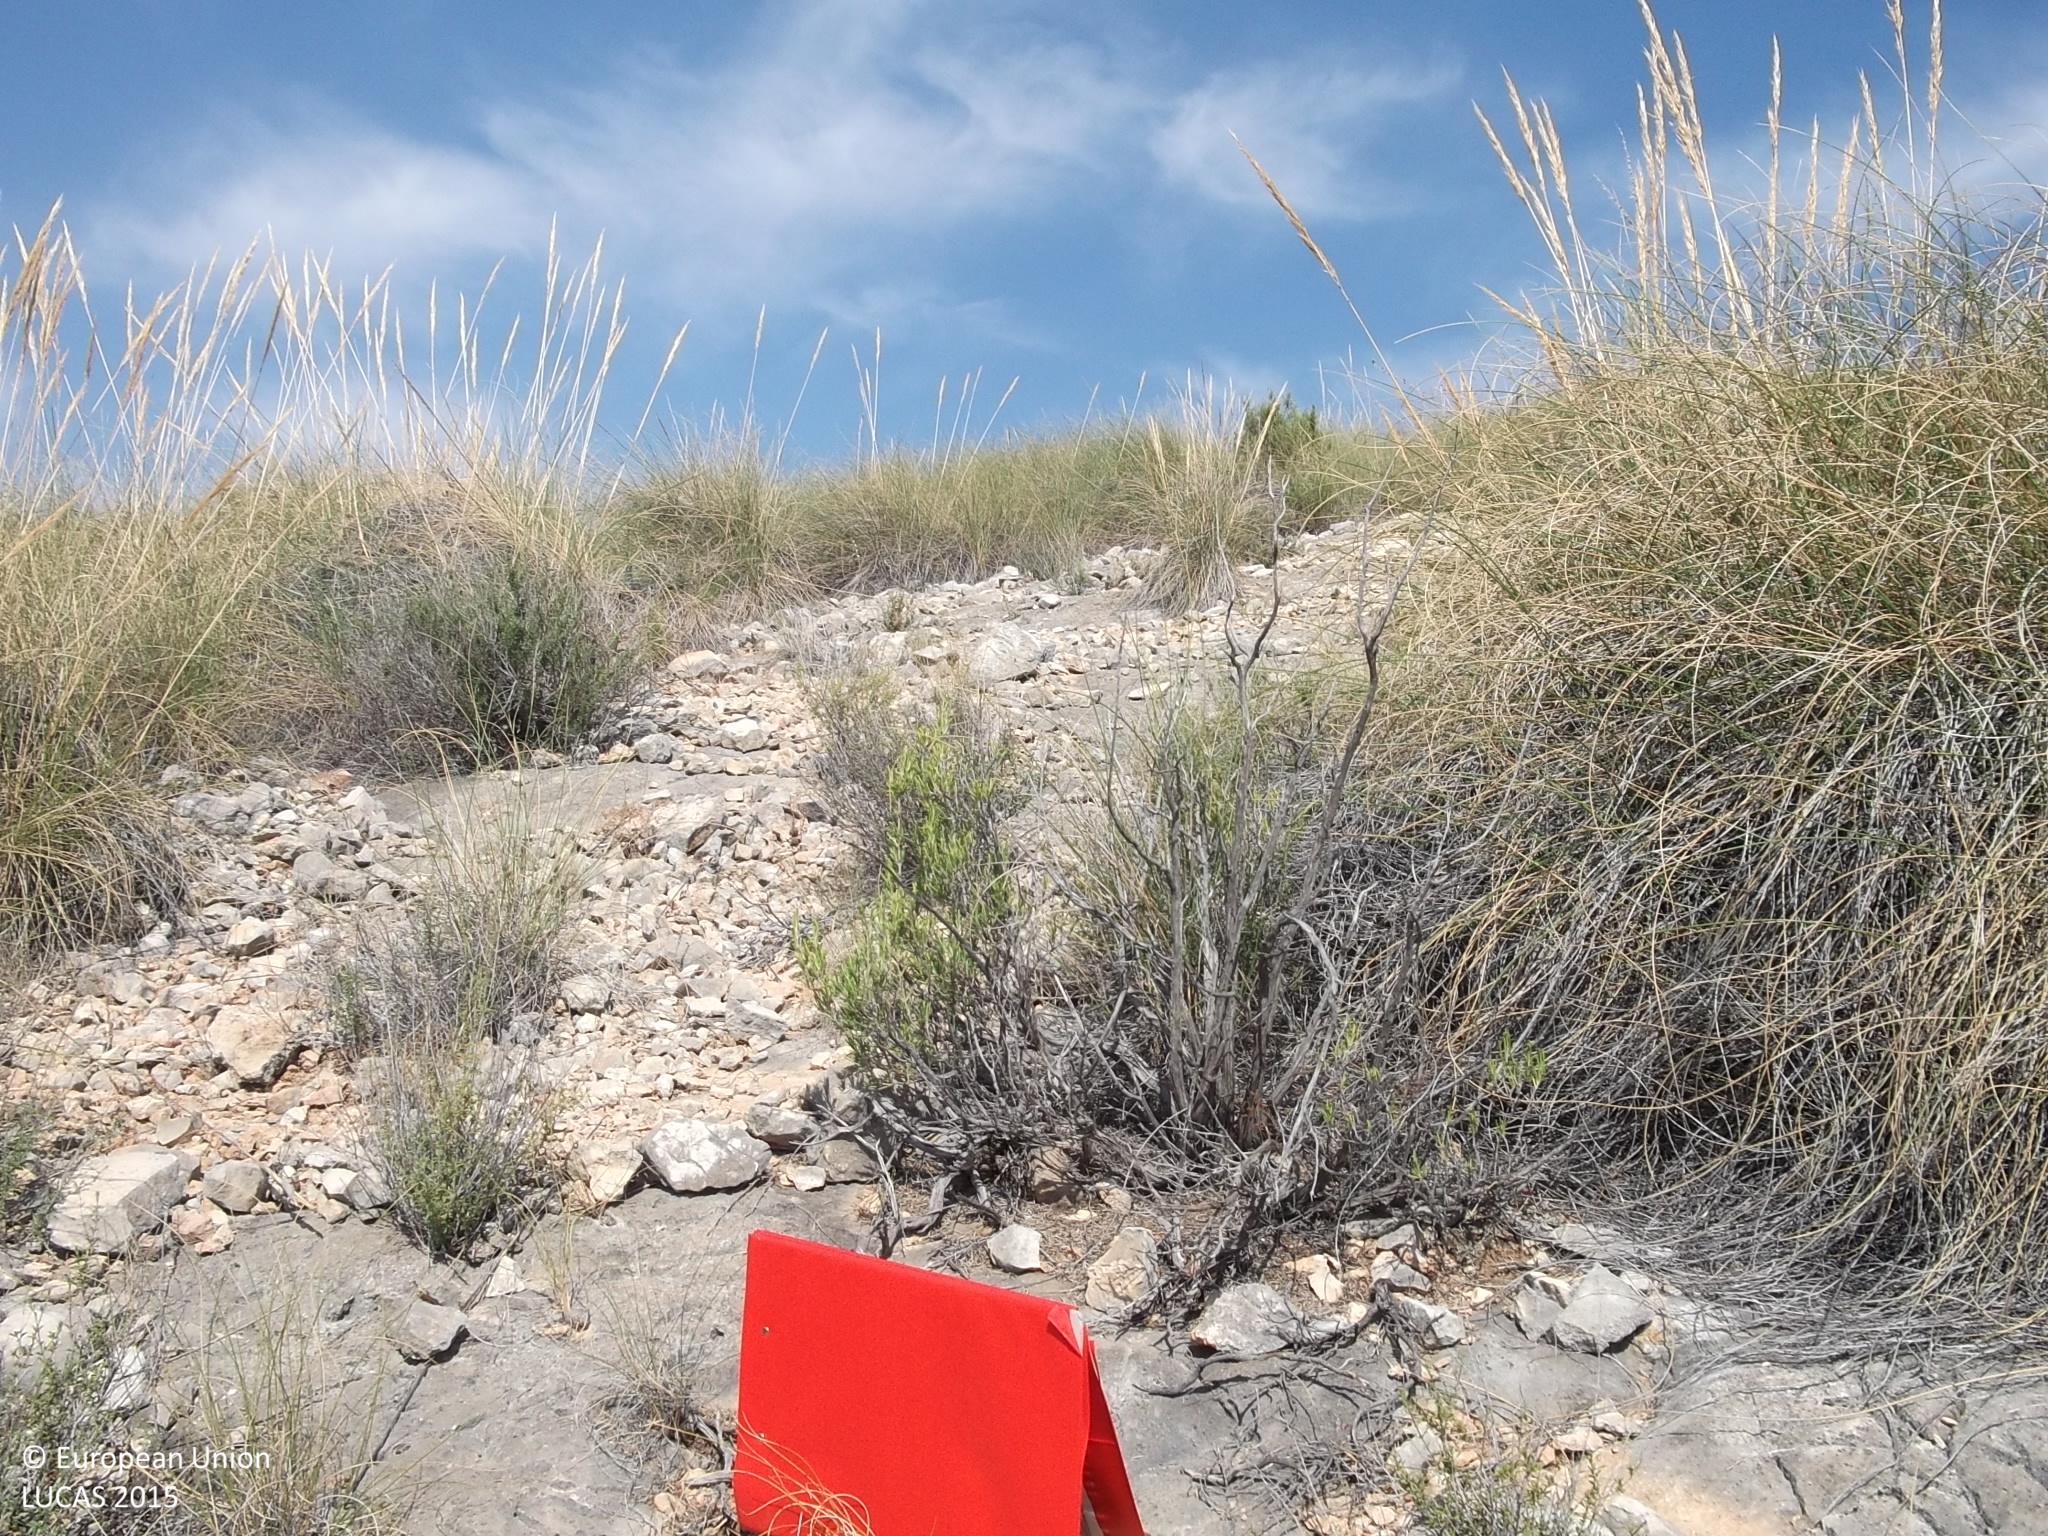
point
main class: Shrubland
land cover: Shrubland without tree cover
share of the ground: 25 - 50 %
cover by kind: shrubs 40 %, herbaceous plants 30 %, consolidated bare surface 30 %
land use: Semi-natural and natural areas not in use
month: June
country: ES
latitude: 38.4354
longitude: -1.3664
